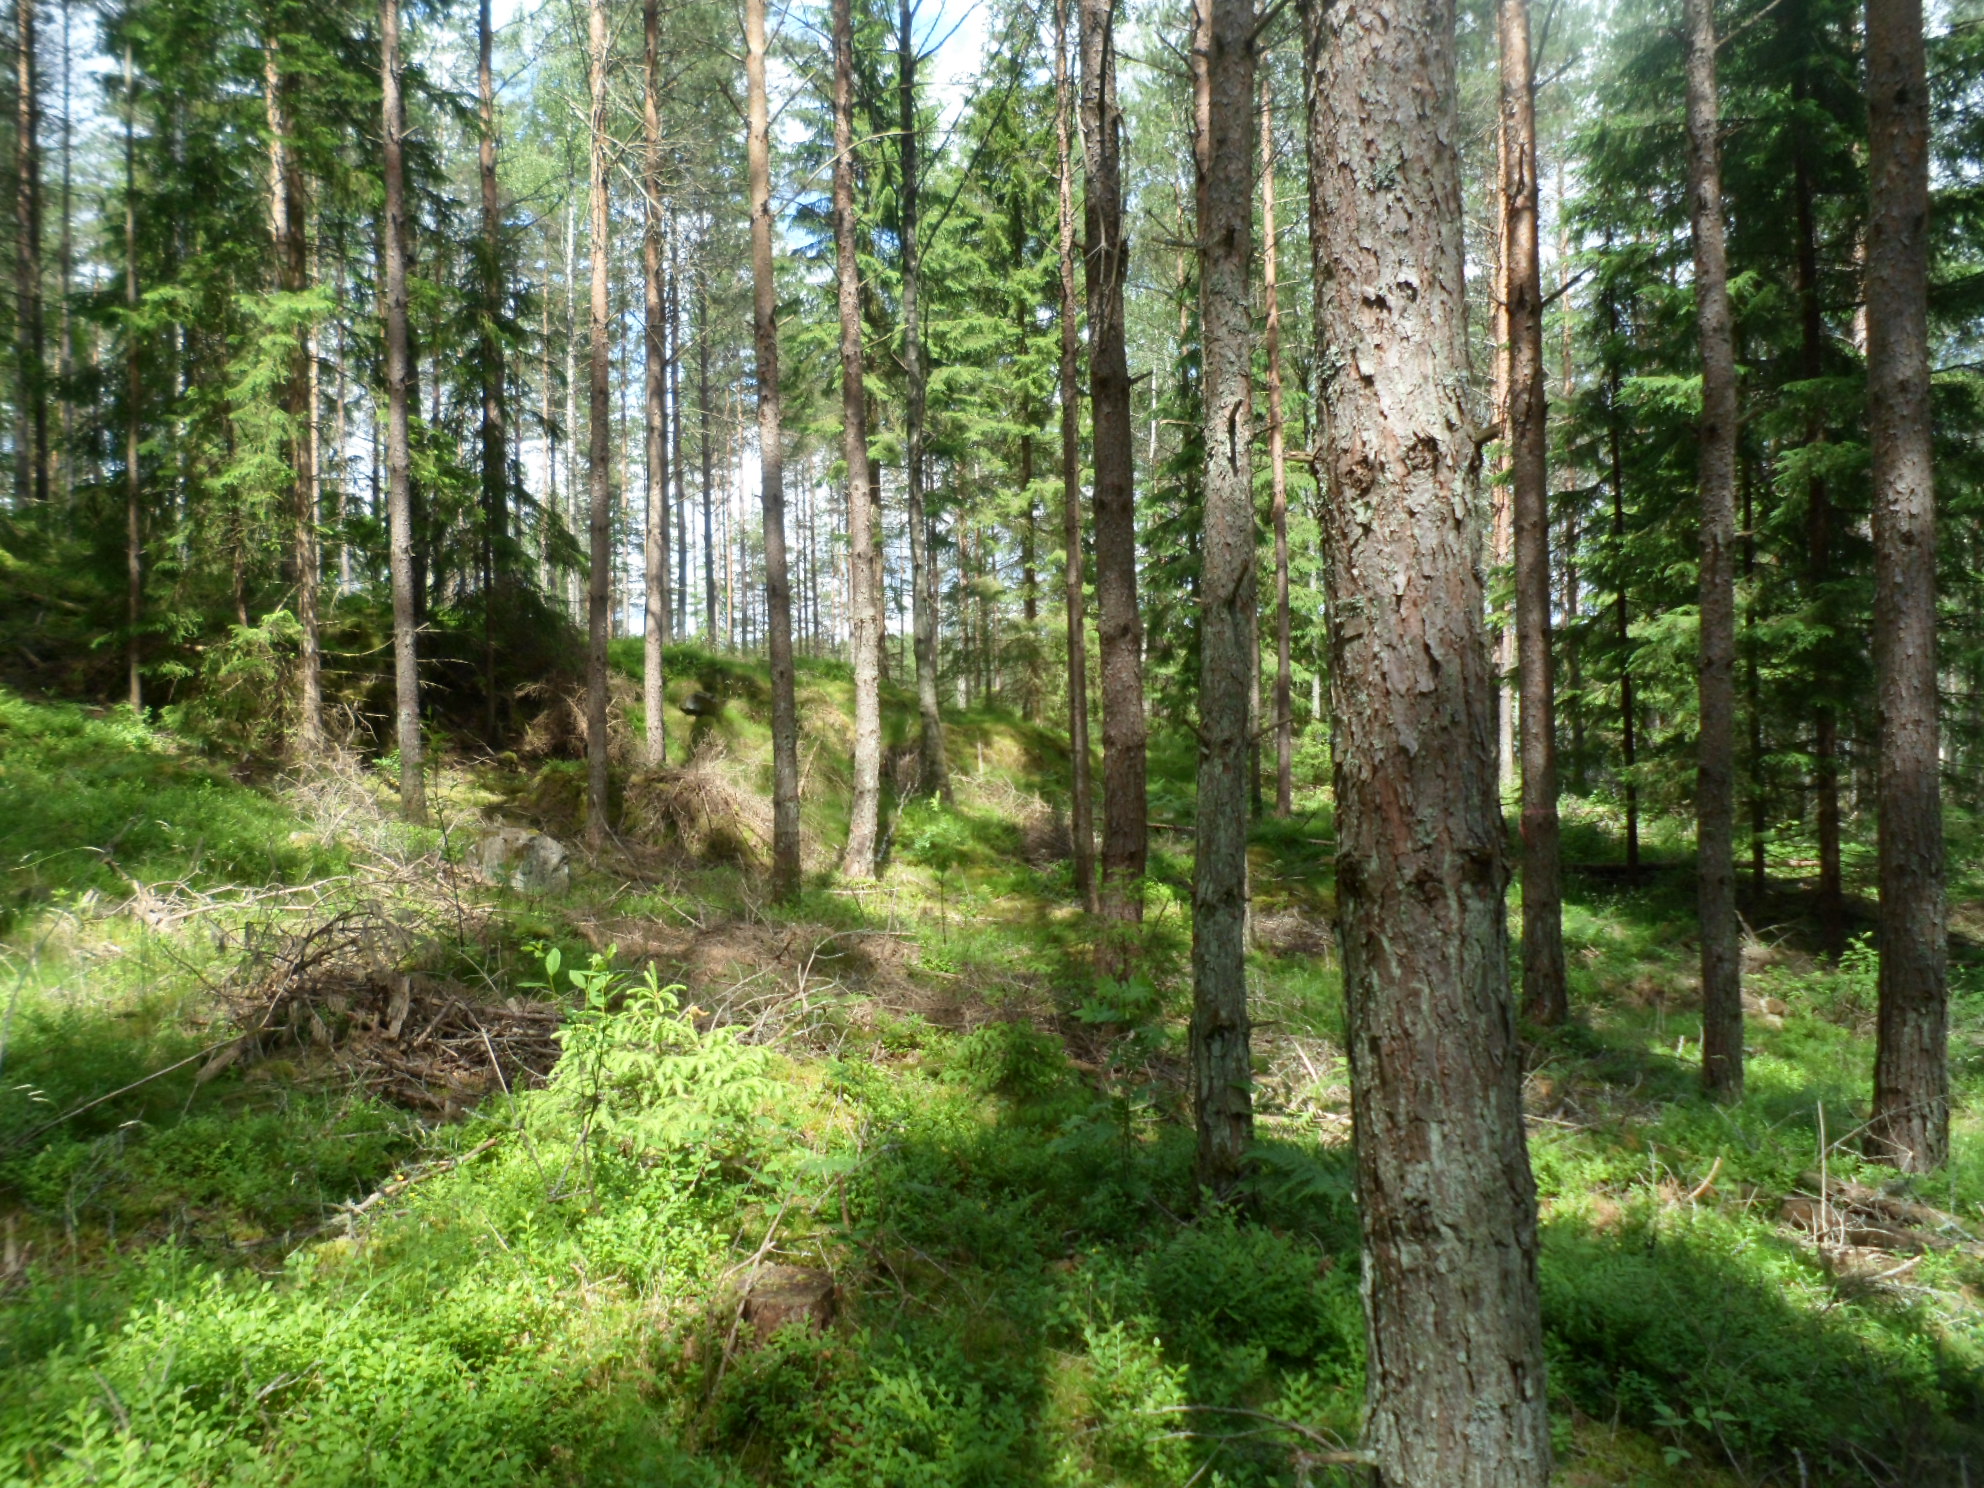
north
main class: Woodland
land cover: Pine dominated coniferous woodland
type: boreal forest
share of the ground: 50 - 75 %
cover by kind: coniferous forest trees 60 %, shrubs 20 %, lichens and mosses 15 %, herbaceous plants 5 %
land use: Forestry
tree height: > 5 m
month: June
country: SE
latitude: 57.1056
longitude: 14.8340
